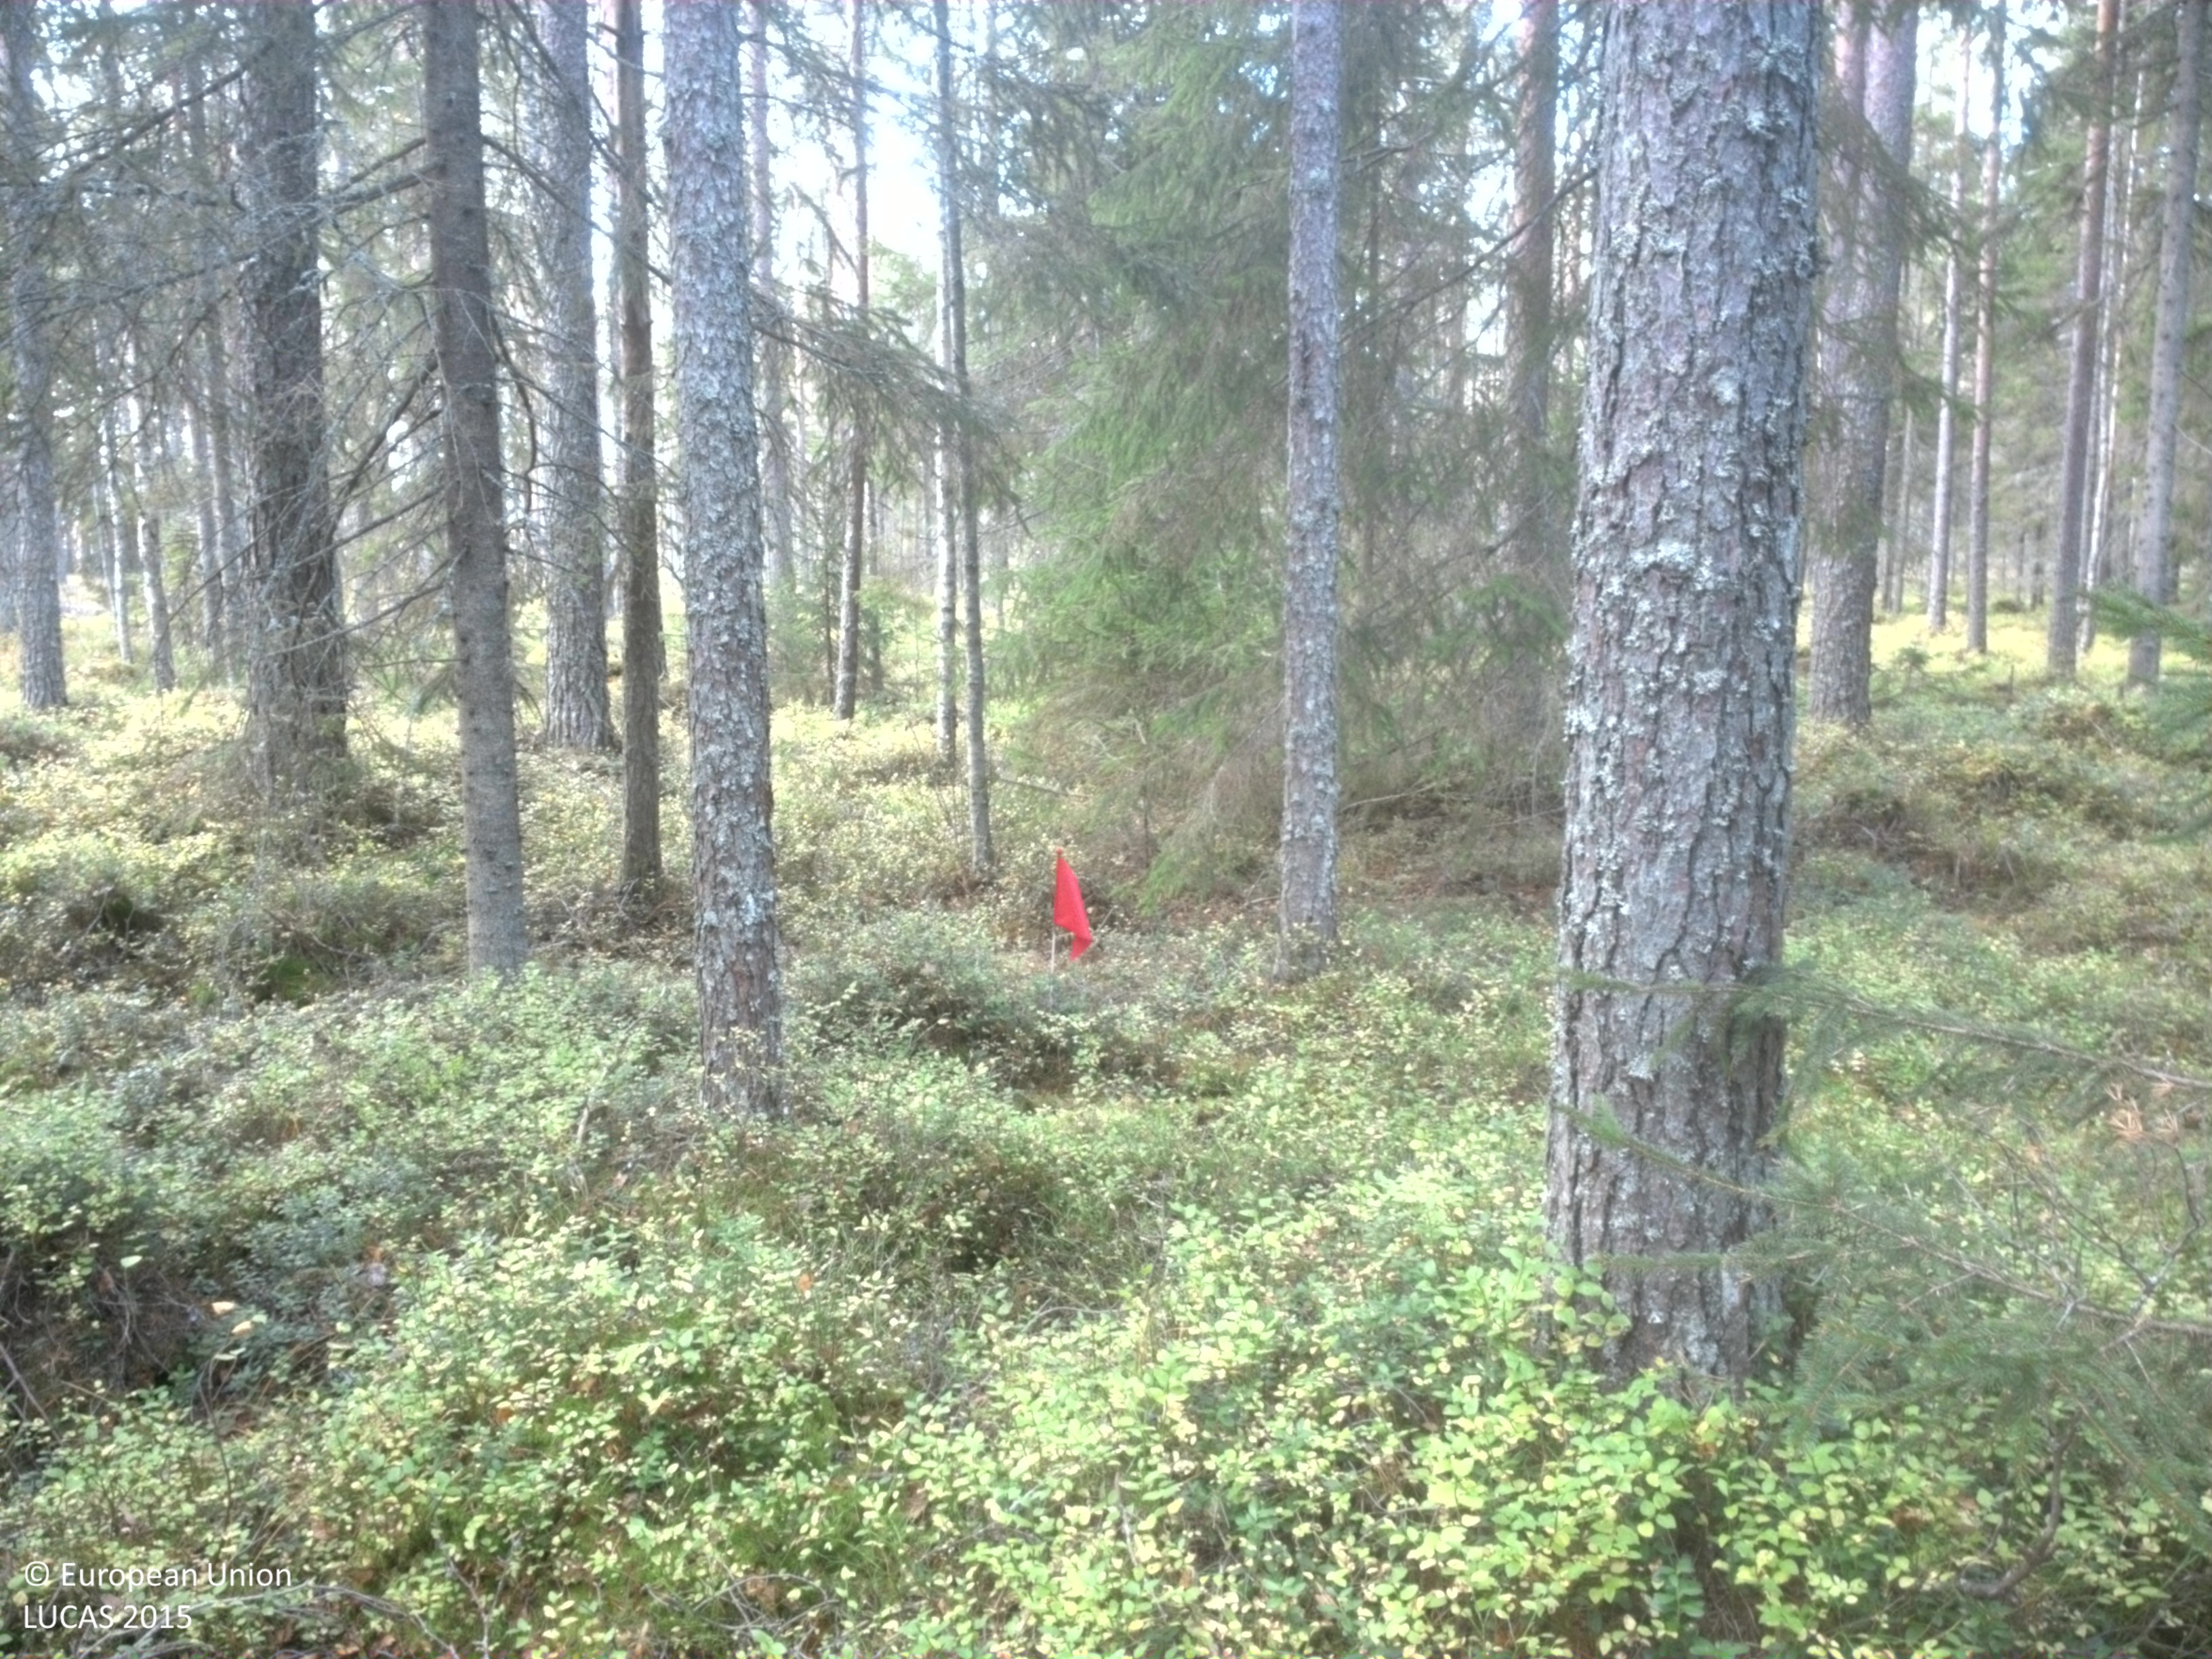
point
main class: Woodland
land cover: Other mixed woodland
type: boreal forest
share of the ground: 50 - 75 %
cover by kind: coniferous forest trees 45 %, shrubs 35 %, broadleaved forest trees 20 %
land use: Forestry
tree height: > 5 m
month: October
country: SE
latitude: 63.9953
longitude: 20.7570
